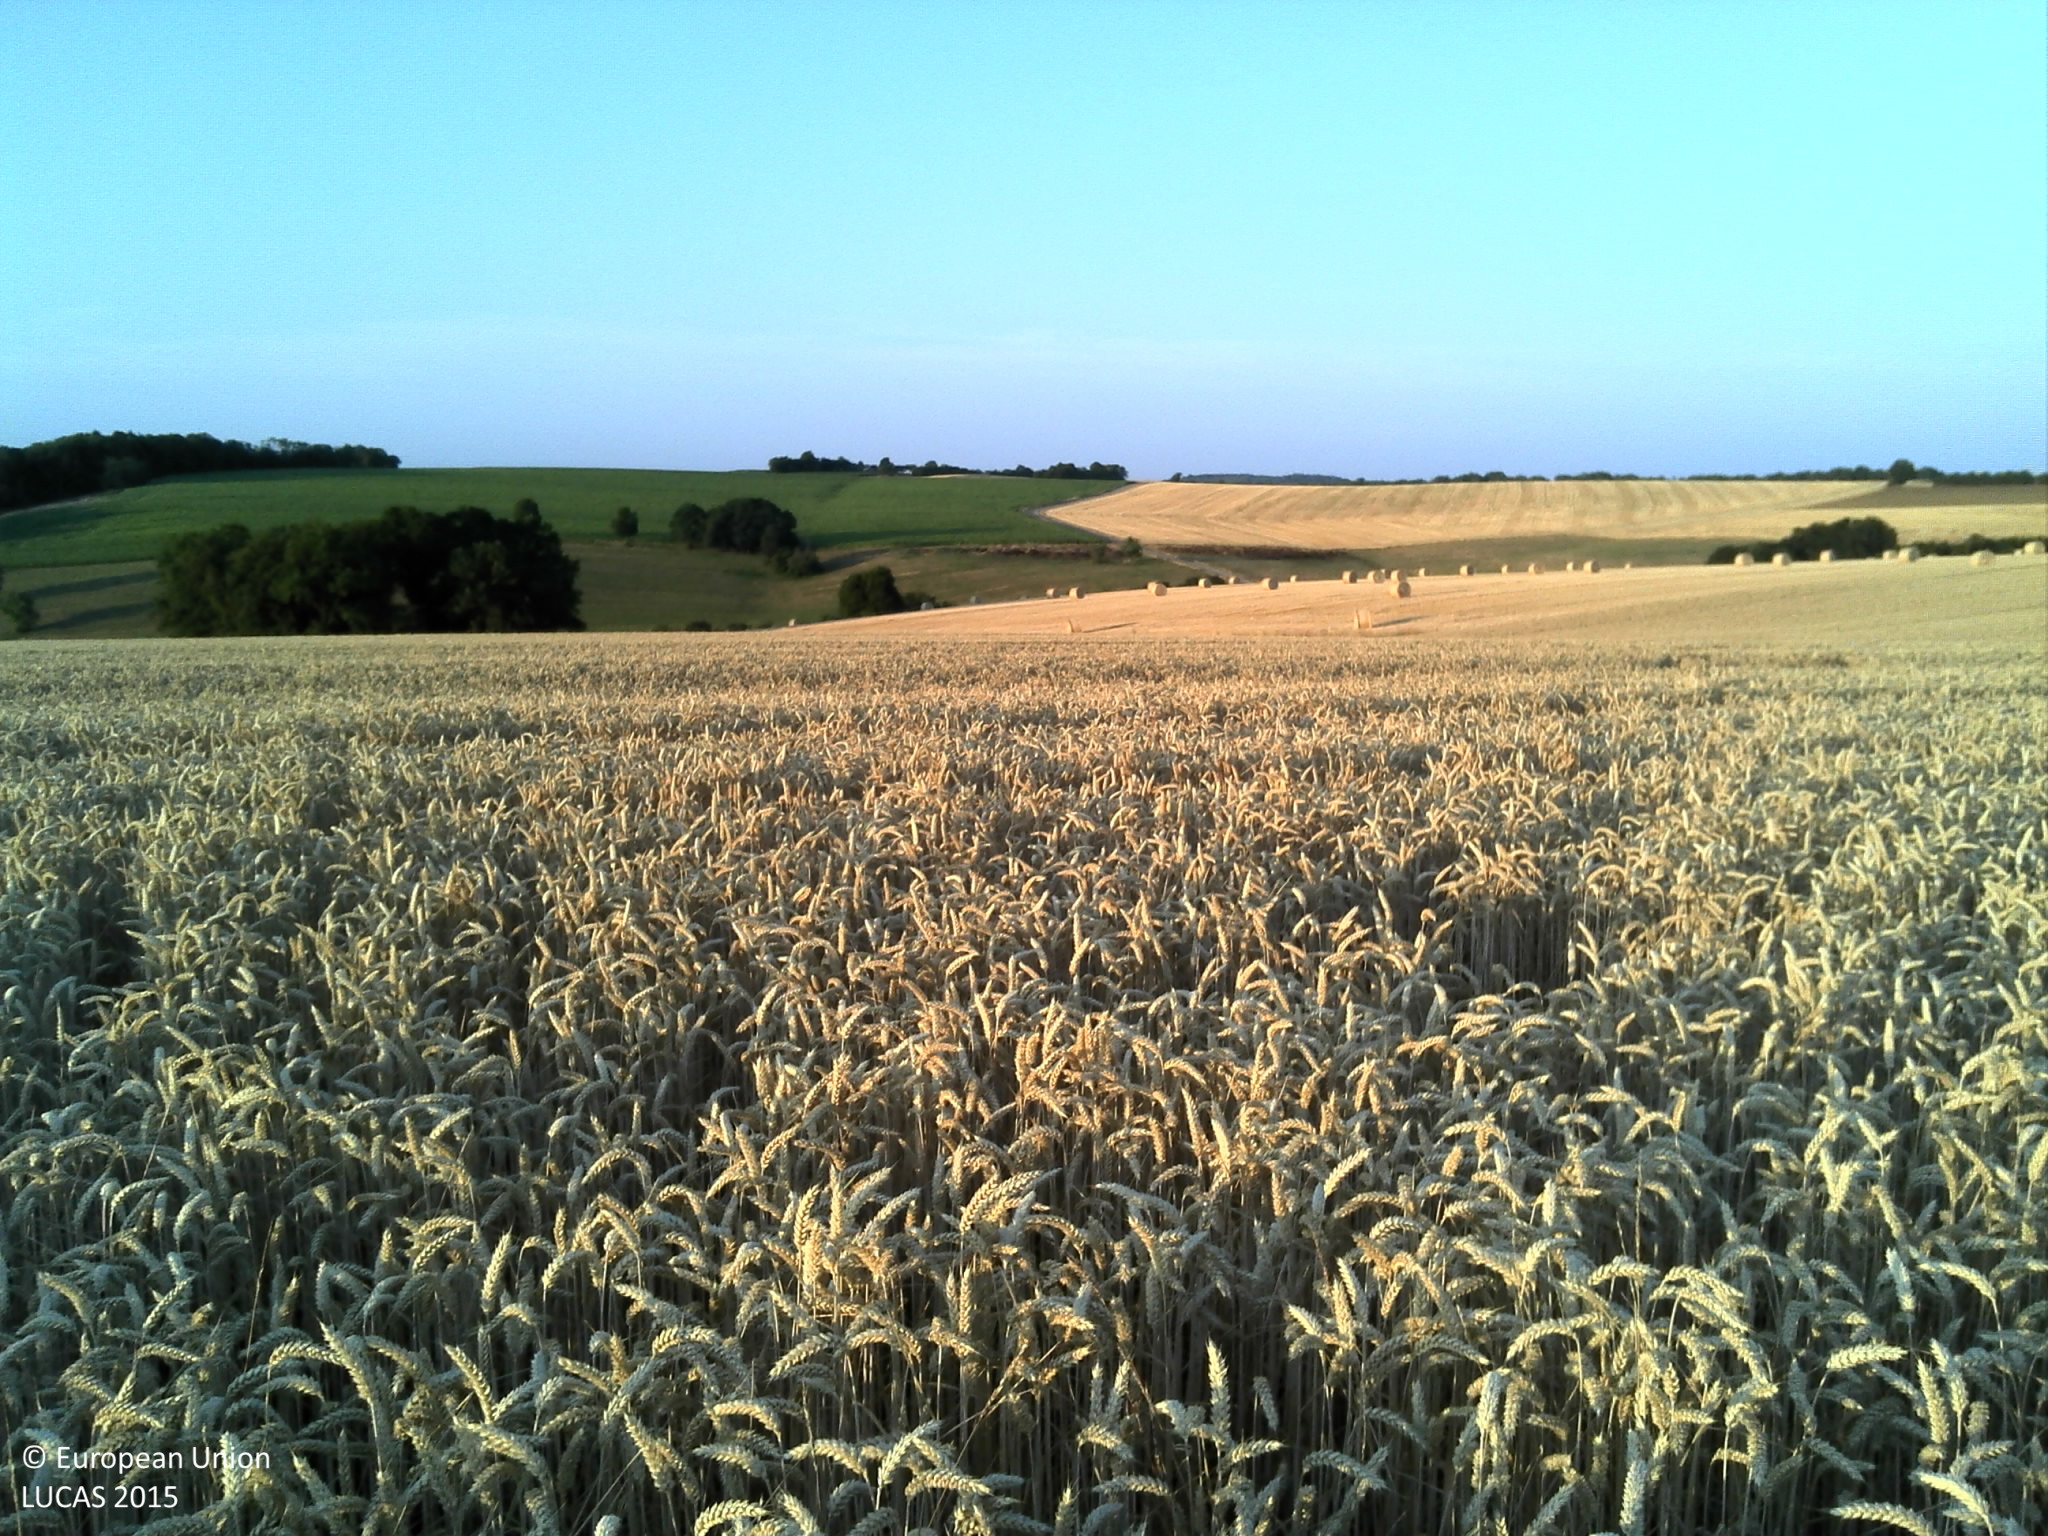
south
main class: Cropland
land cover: Common wheat
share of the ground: > 75 %
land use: Agriculture (excluding fallow land and kitchen gardens)
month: July
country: FR
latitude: 48.1911
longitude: 6.1128
